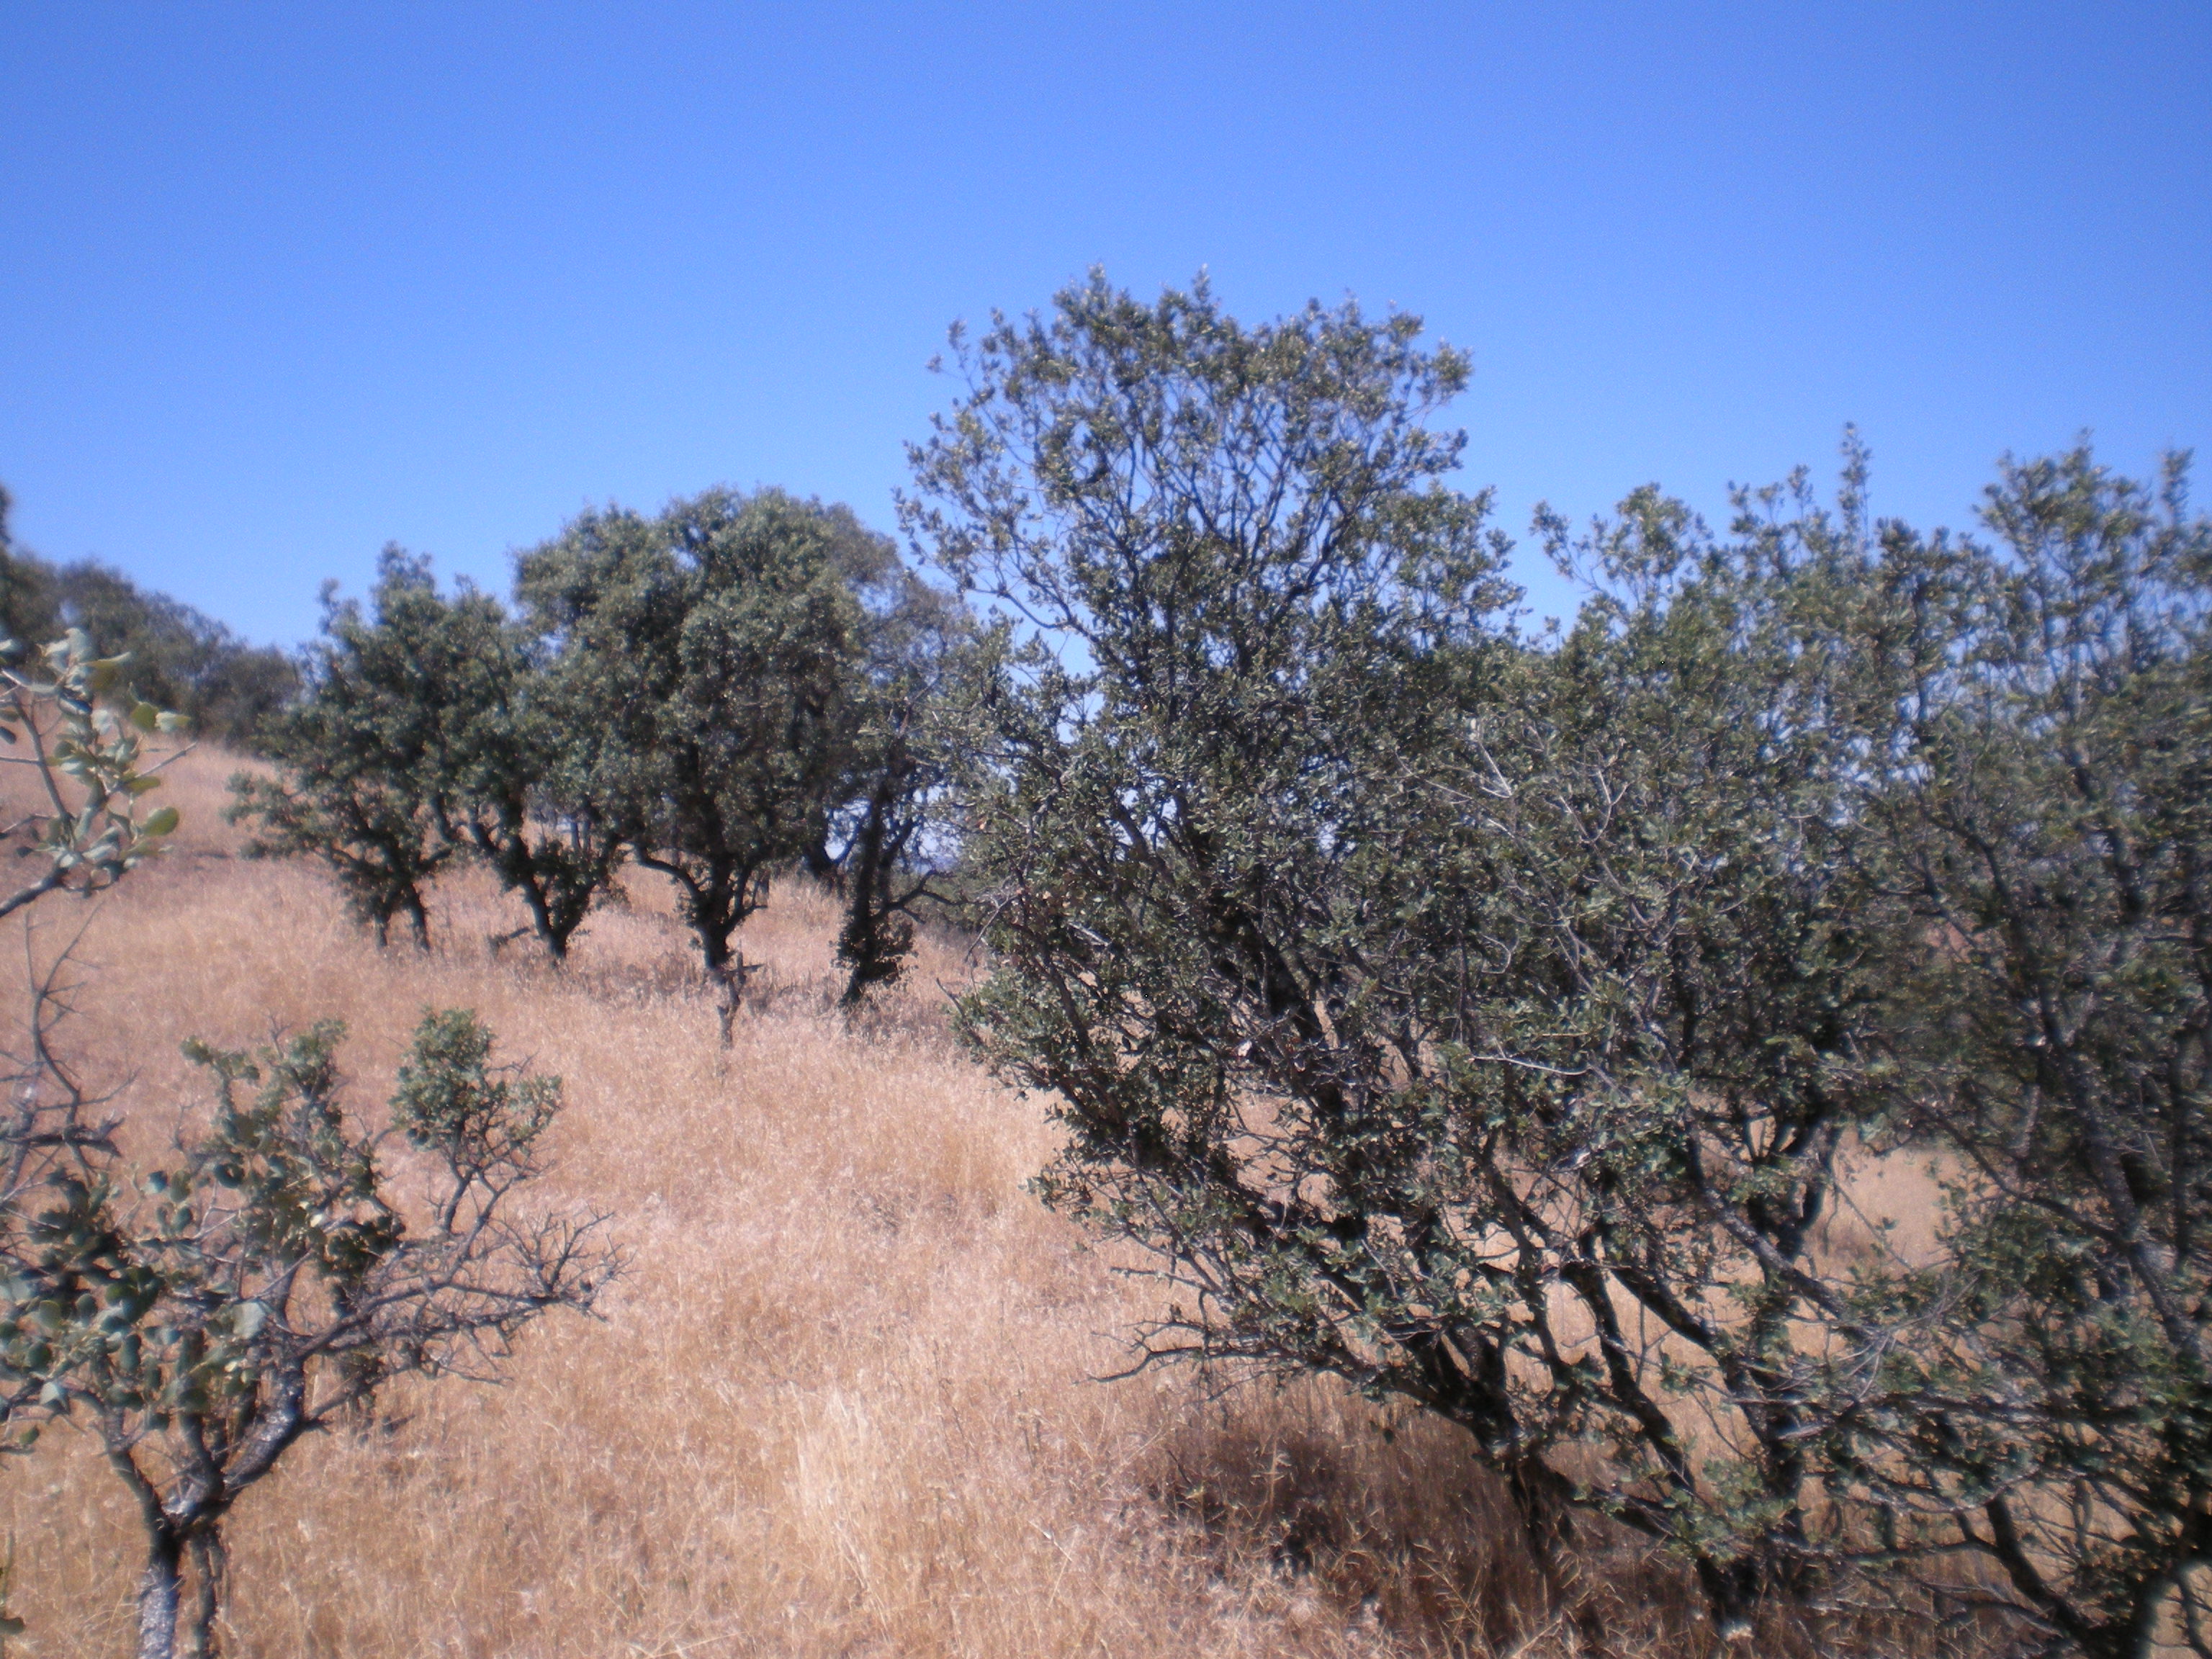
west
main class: Woodland
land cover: Broadleaved woodland
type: broadleaved evergreen forest
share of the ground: 25 - 50 %
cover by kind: unconsolidated bare surface 50 %, broadleaved forest trees 40 %, shrubs 5 %, herbaceous plants 5 %
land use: Semi-natural and natural areas not in use
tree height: < 5 m
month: May
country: ES
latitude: 38.4875
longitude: -3.3629
